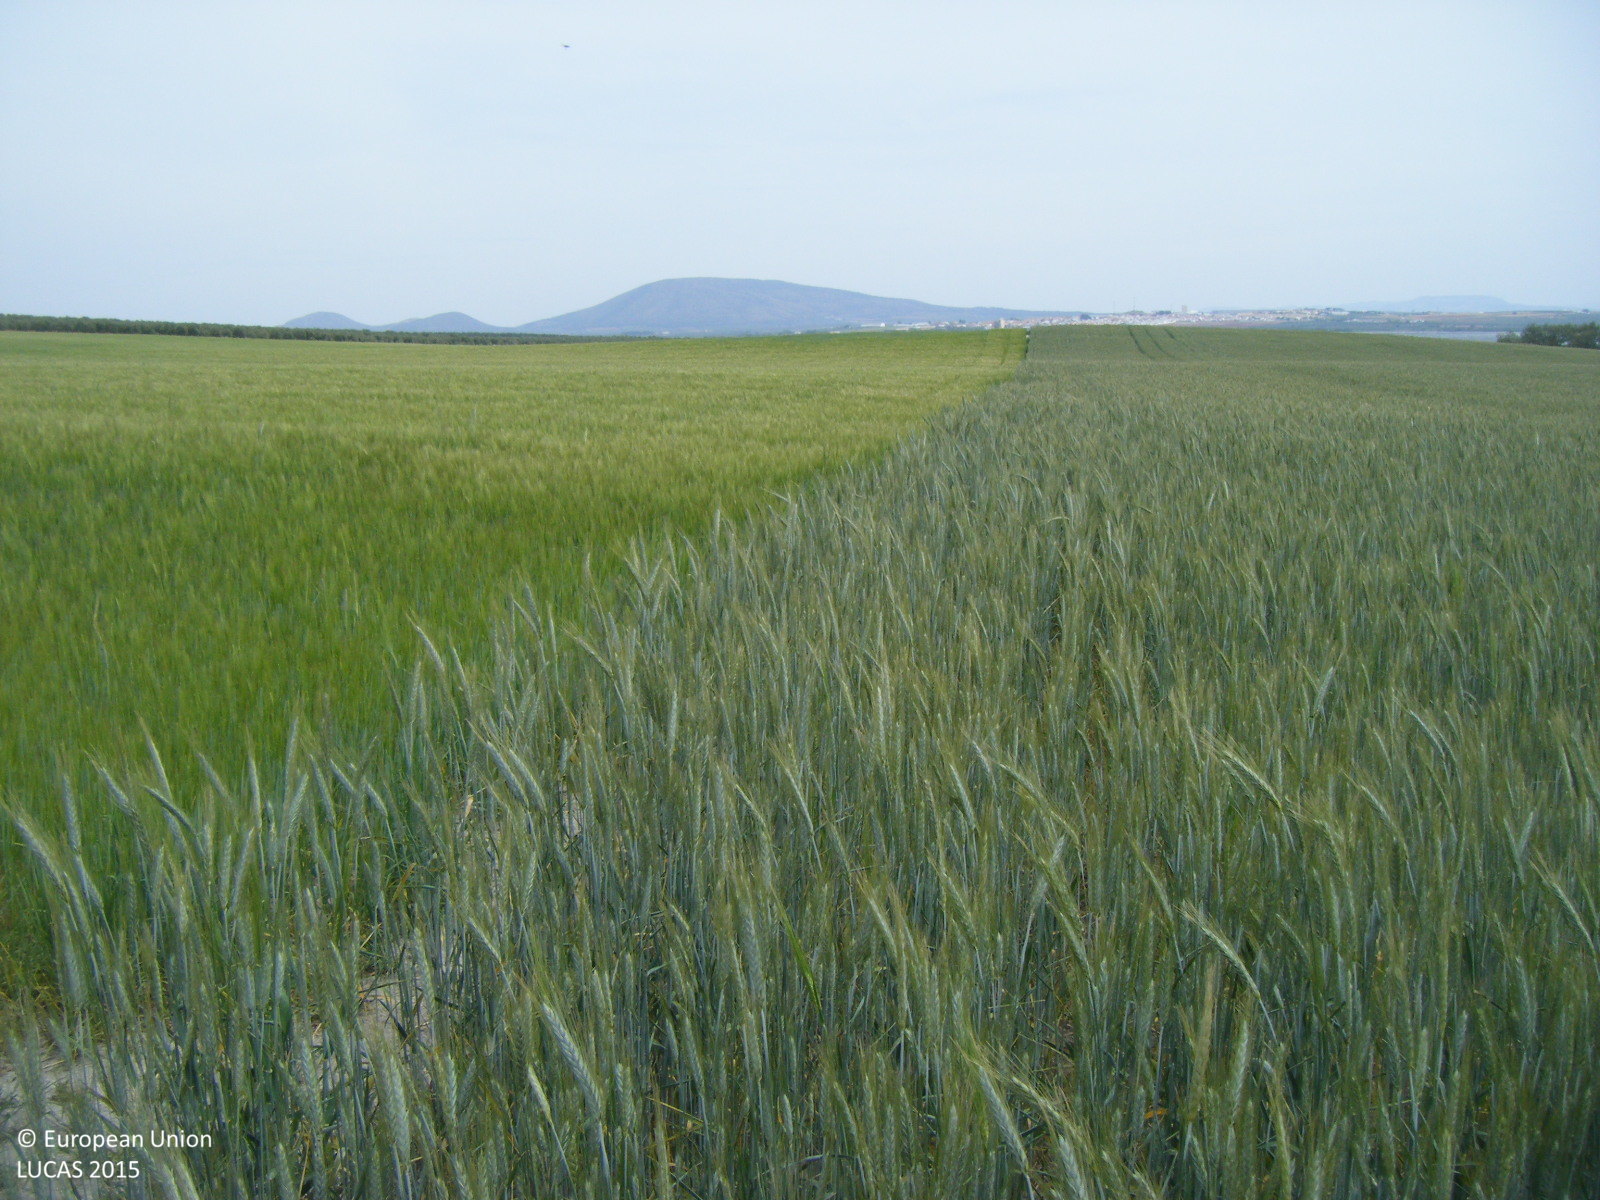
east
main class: Shrubland
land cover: Shrubland without tree cover
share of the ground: > 75 %
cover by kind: shrubs 80 %, herbaceous plants 20 %
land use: Semi-natural and natural areas not in use
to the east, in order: Shrubland without tree cover; Inland fresh water bodies
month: April
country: ES
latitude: 37.1195
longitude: -4.7785
